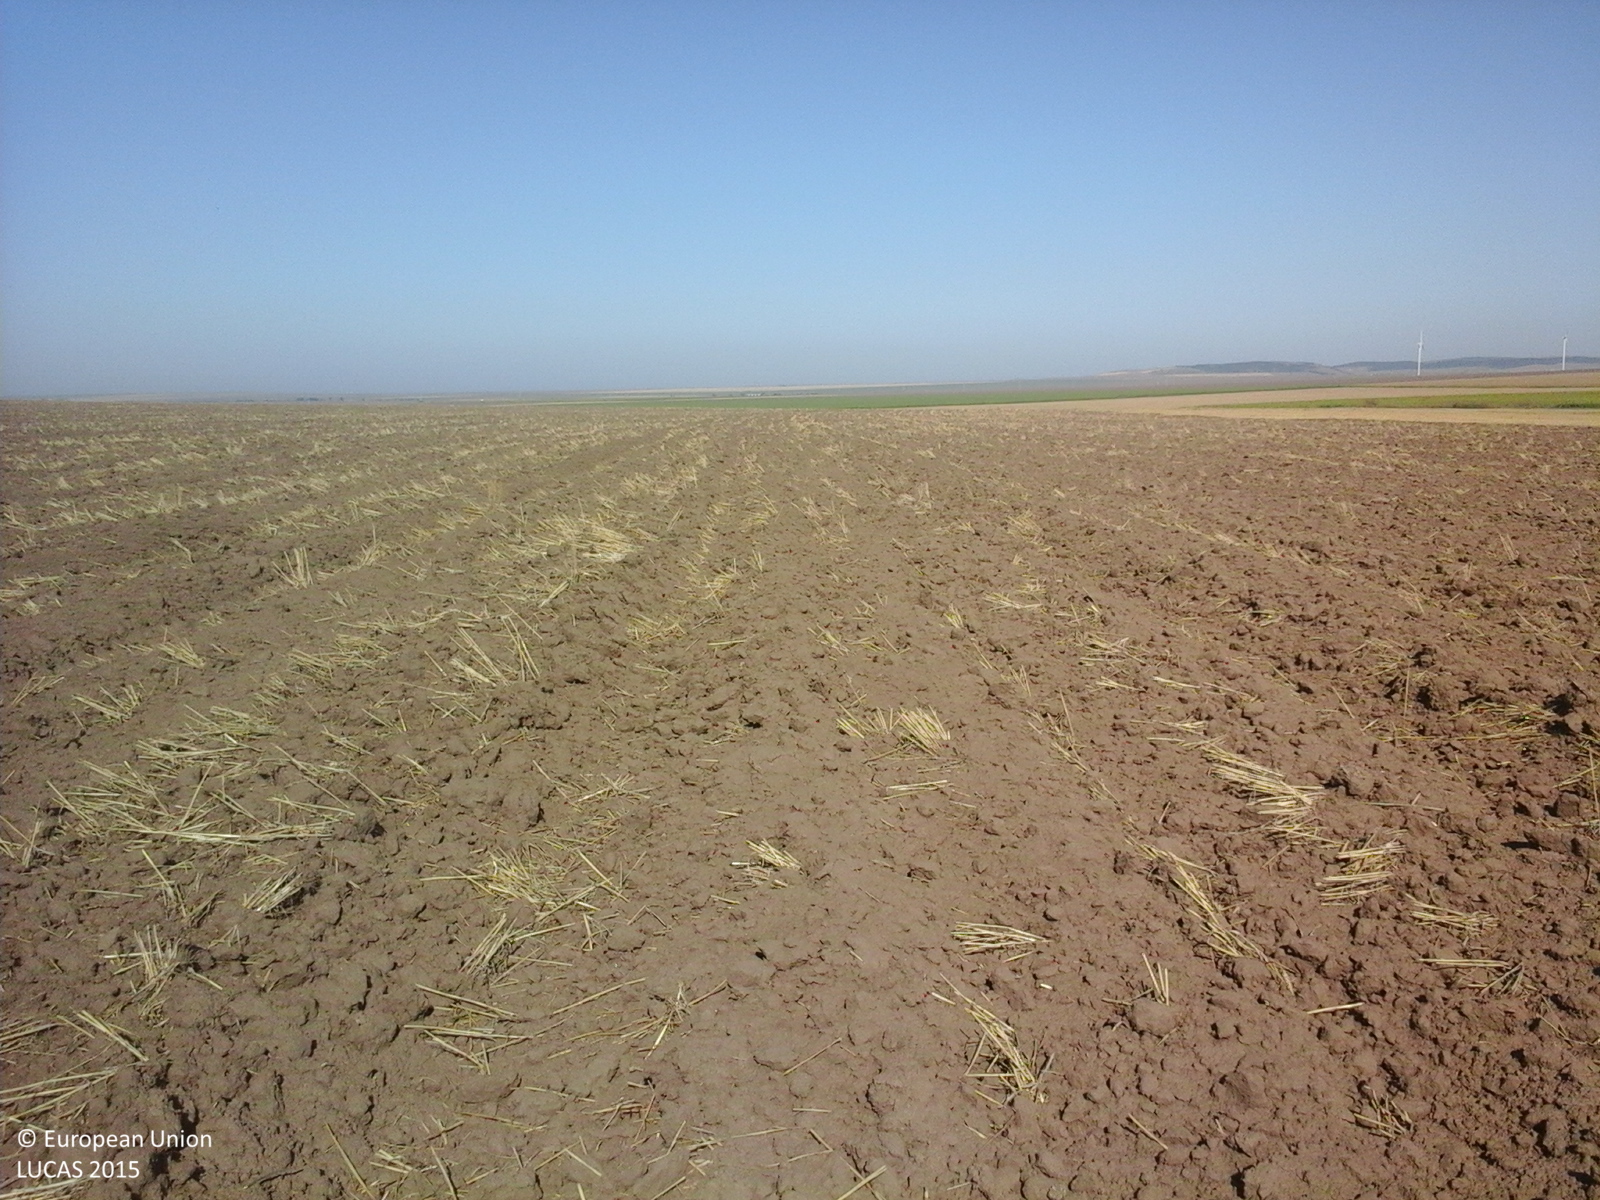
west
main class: Cropland
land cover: Common wheat
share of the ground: < 10 %
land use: Agriculture (excluding fallow land and kitchen gardens)
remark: Harvested field
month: August
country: RO
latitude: 44.4546
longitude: 28.3273
